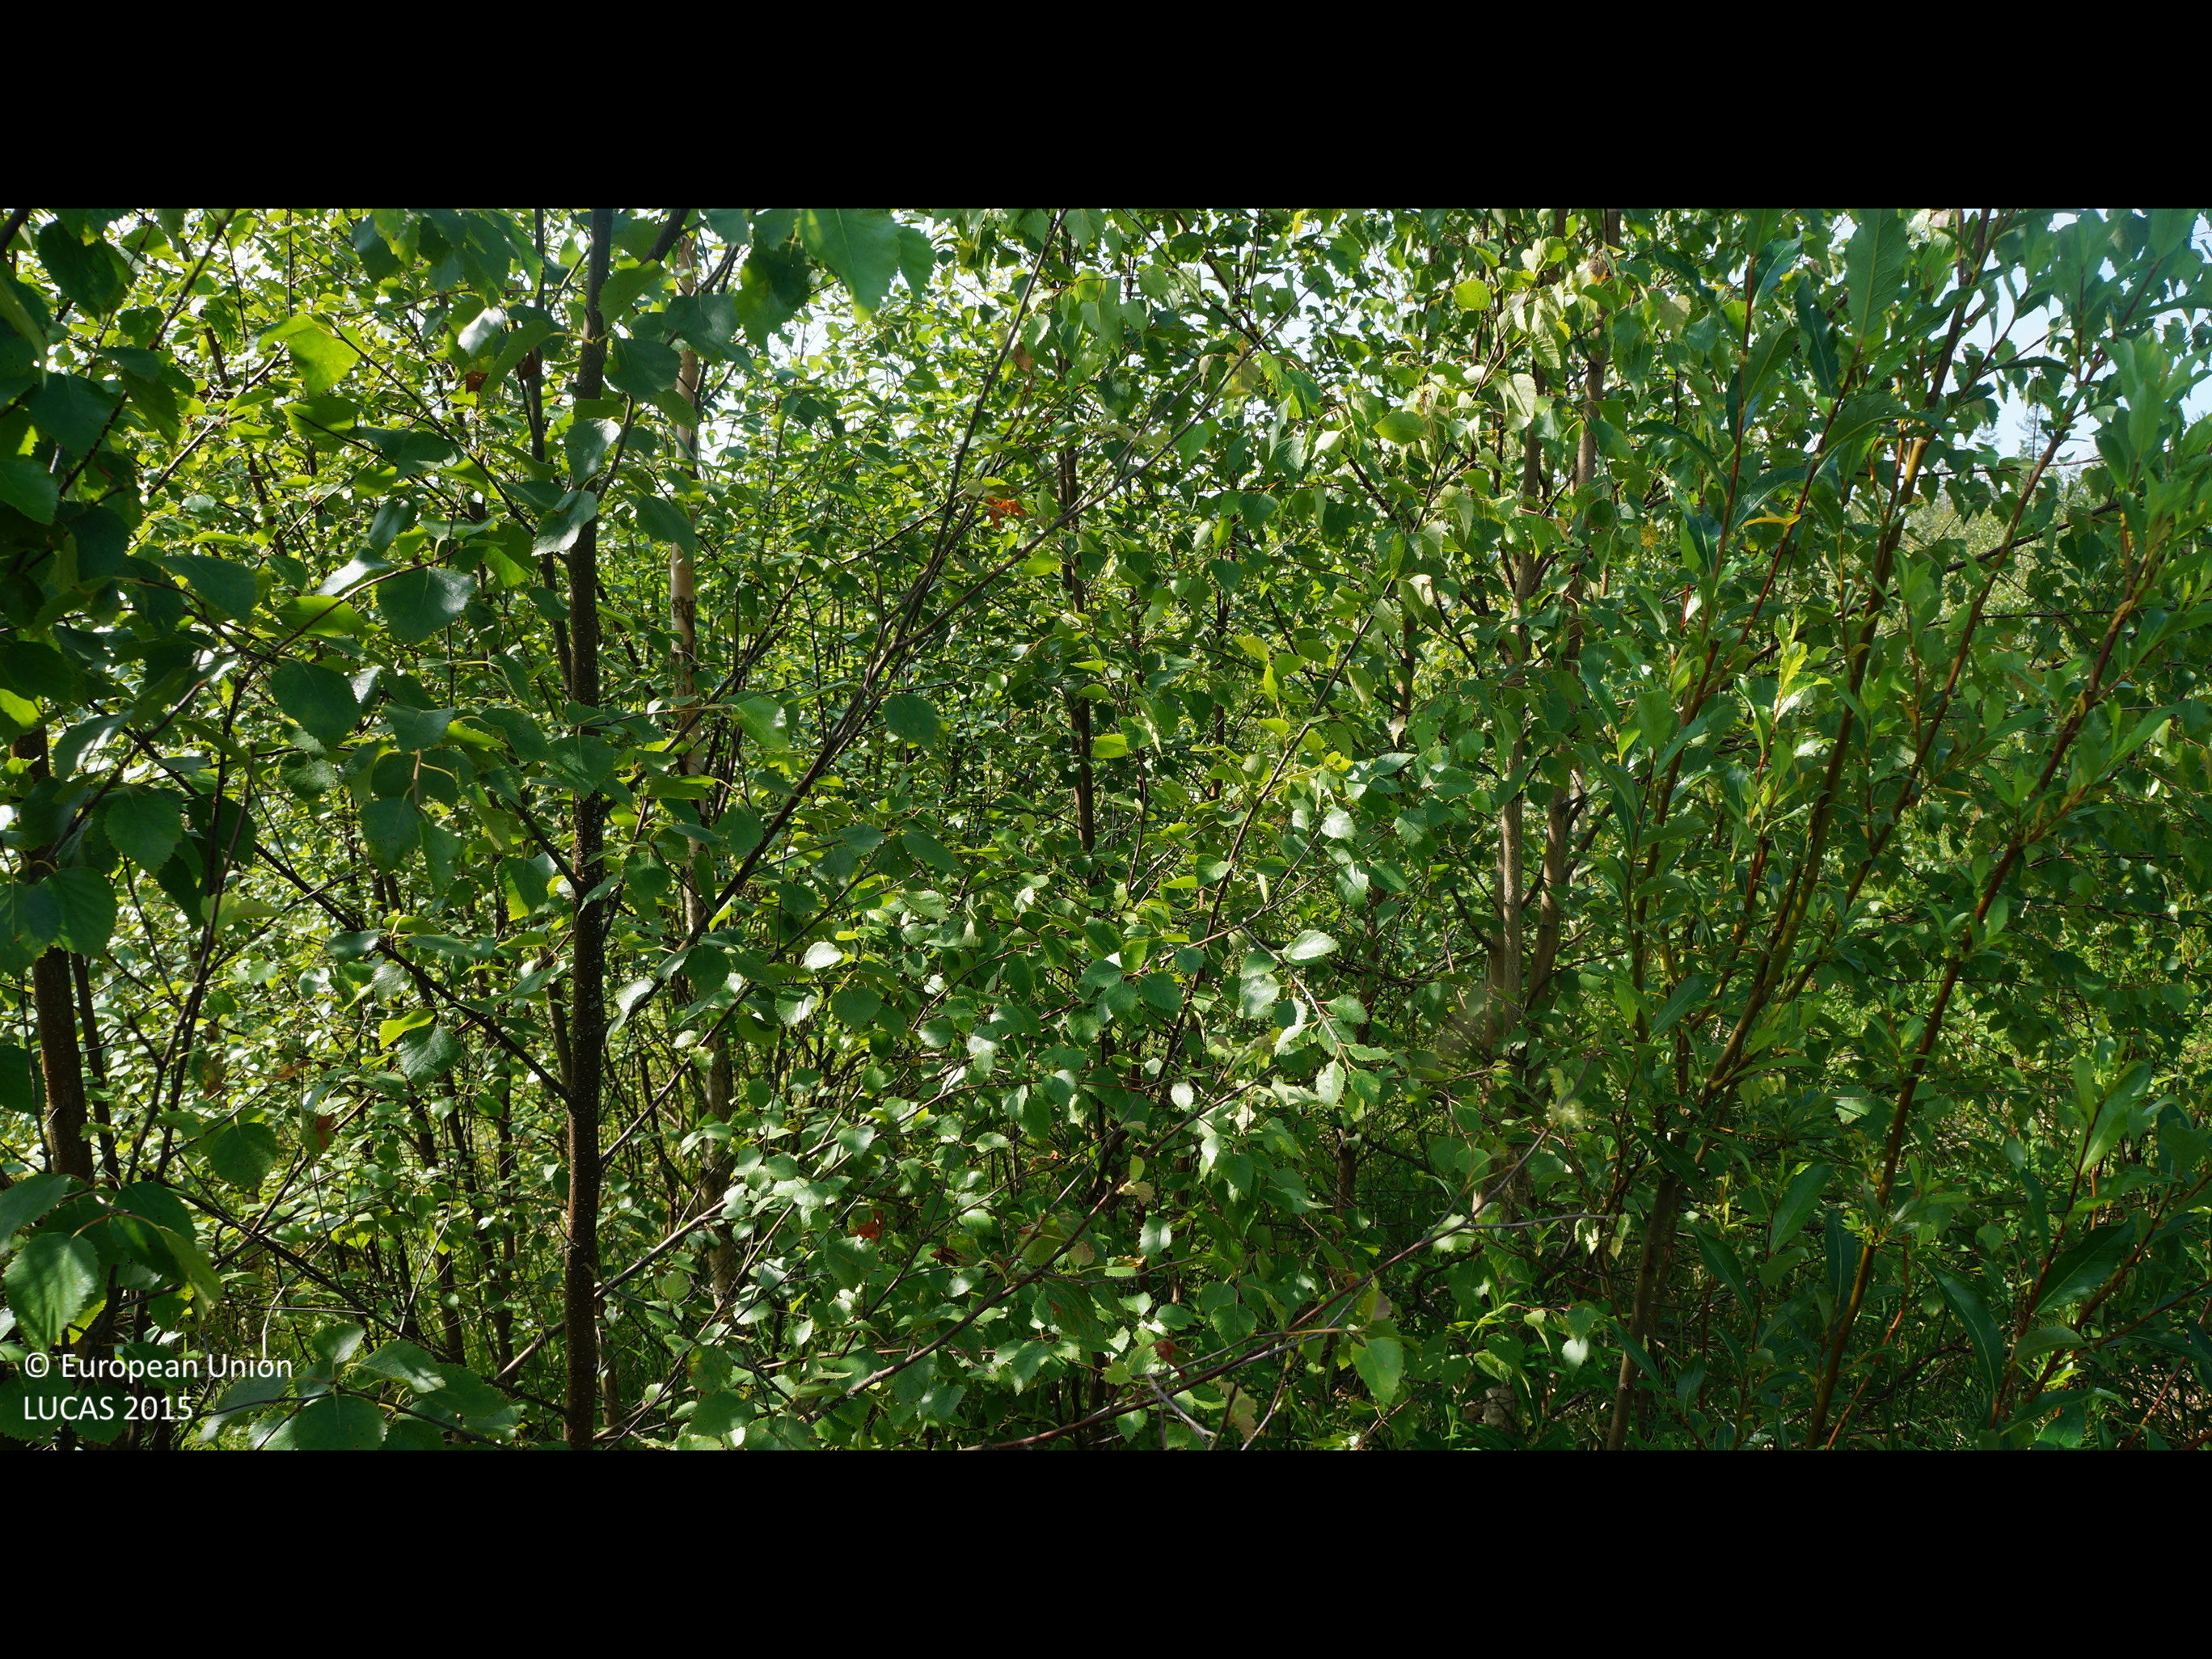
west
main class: Woodland
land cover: Broadleaved woodland
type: boreal forest
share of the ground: 25 - 50 %
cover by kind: shrubs 50 %, broadleaved forest trees 30 %, coniferous forest trees 10 %, herbaceous plants 10 %
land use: Forestry
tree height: < 5 m
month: July
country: FI
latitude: 64.1953
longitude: 24.4220
